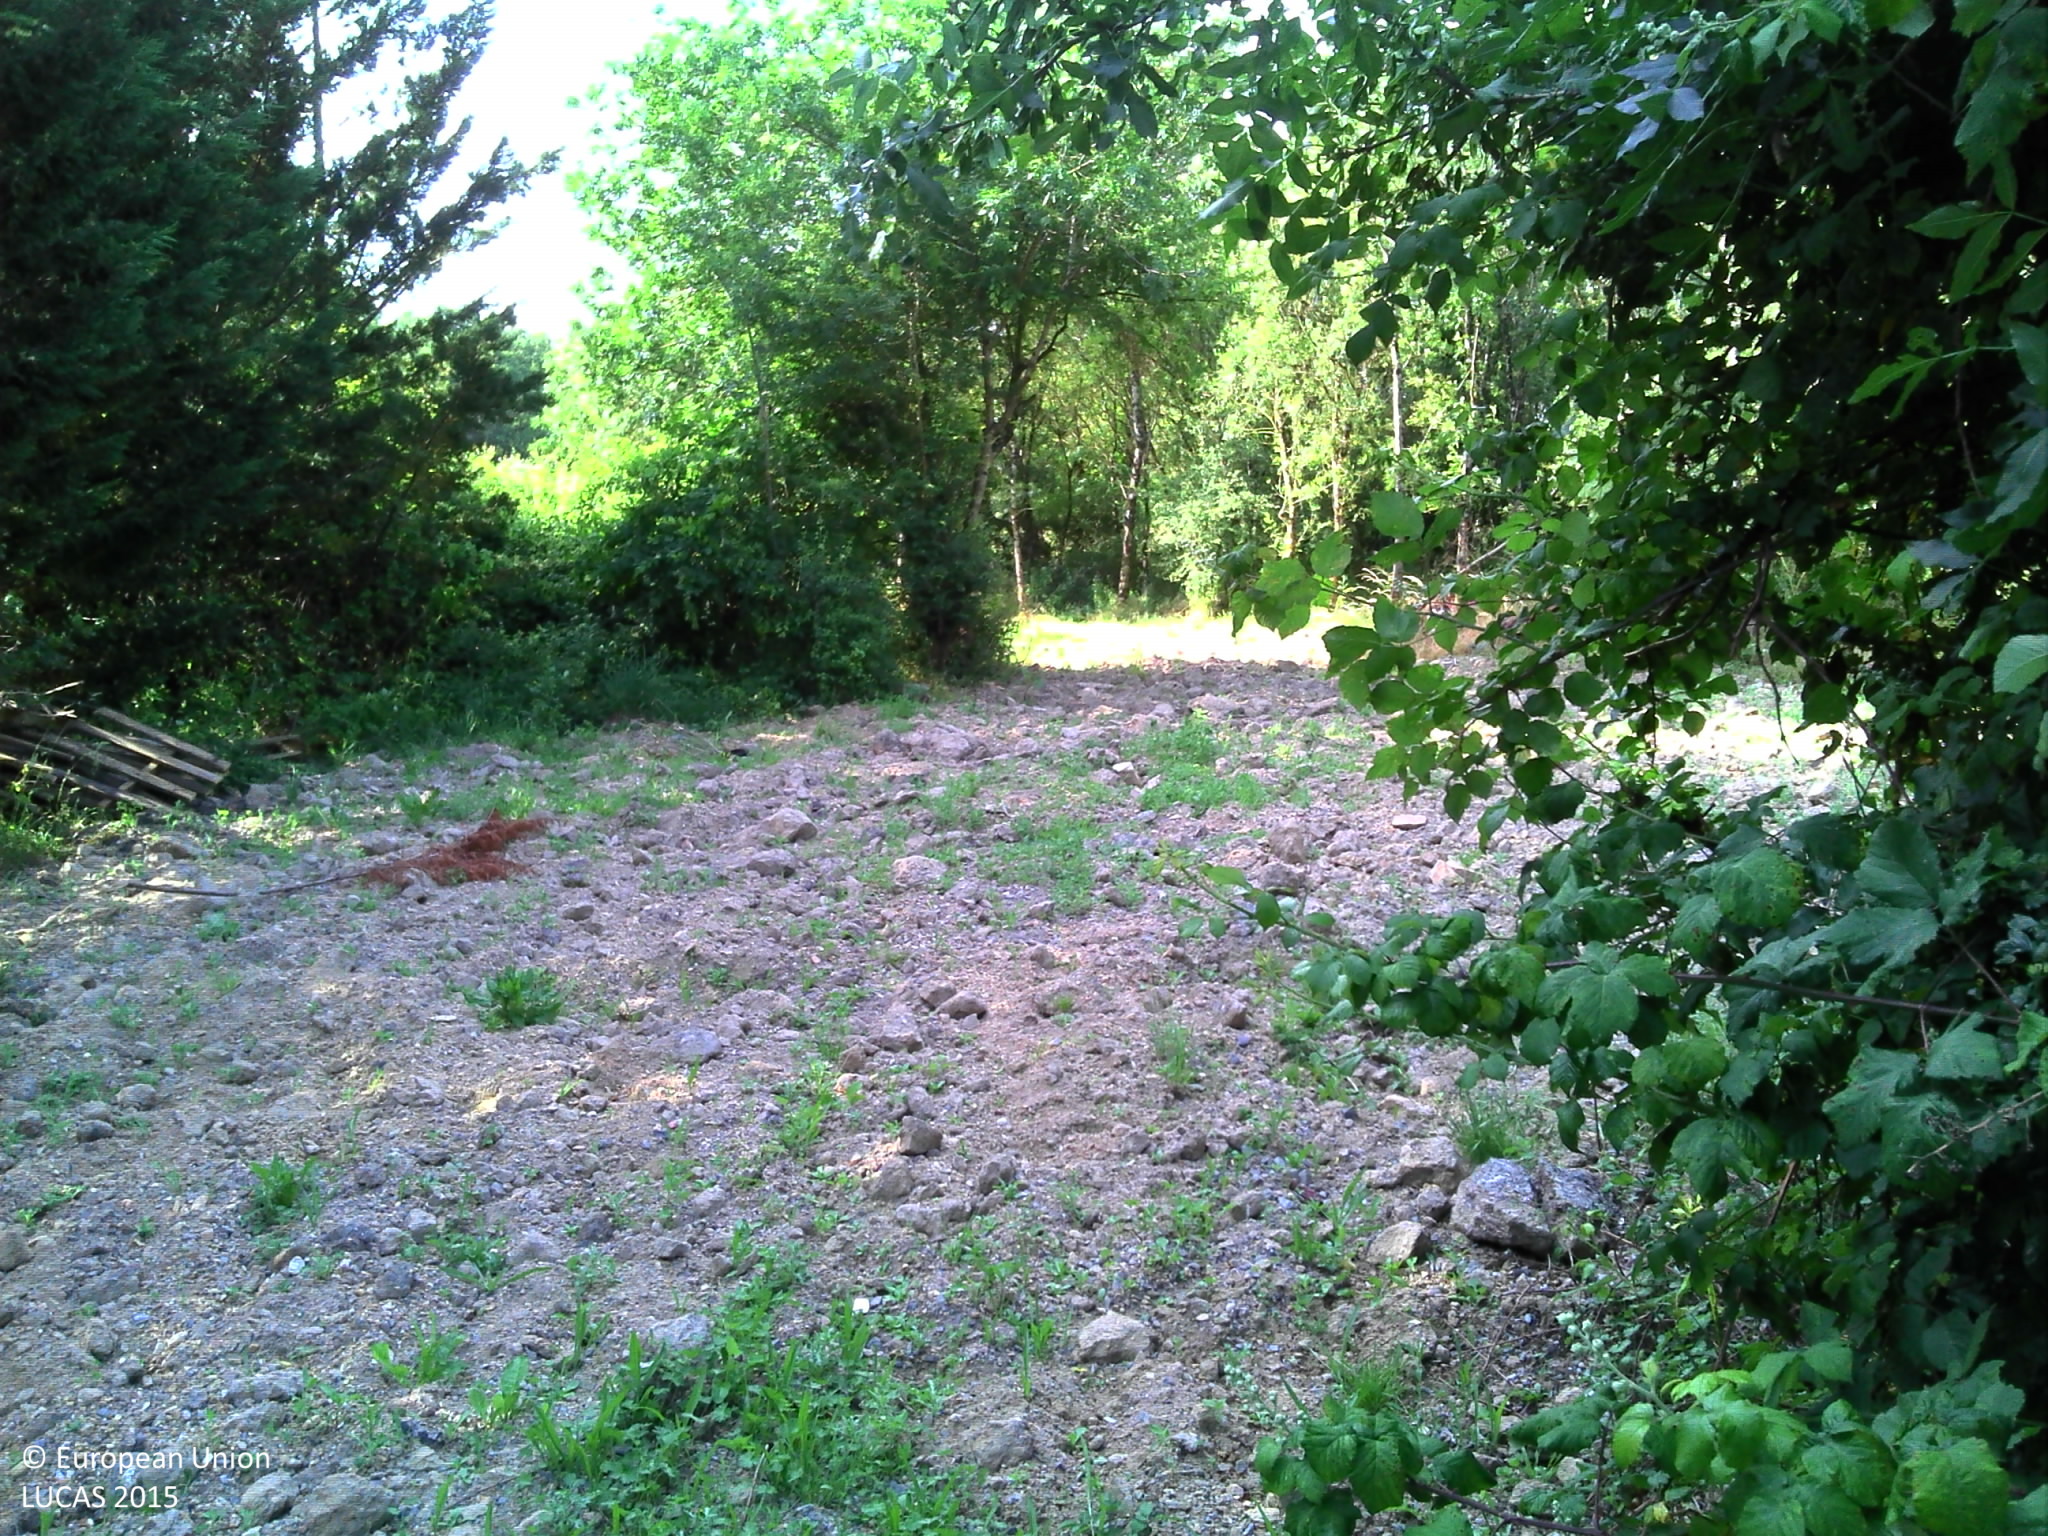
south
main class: Grassland
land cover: Spontaneously vegetated surfaces
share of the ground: > 75 %
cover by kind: herbaceous plants 95 %, shrubs 5 %
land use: Abandoned areas
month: June
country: FR
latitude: 47.1618
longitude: -1.5309
